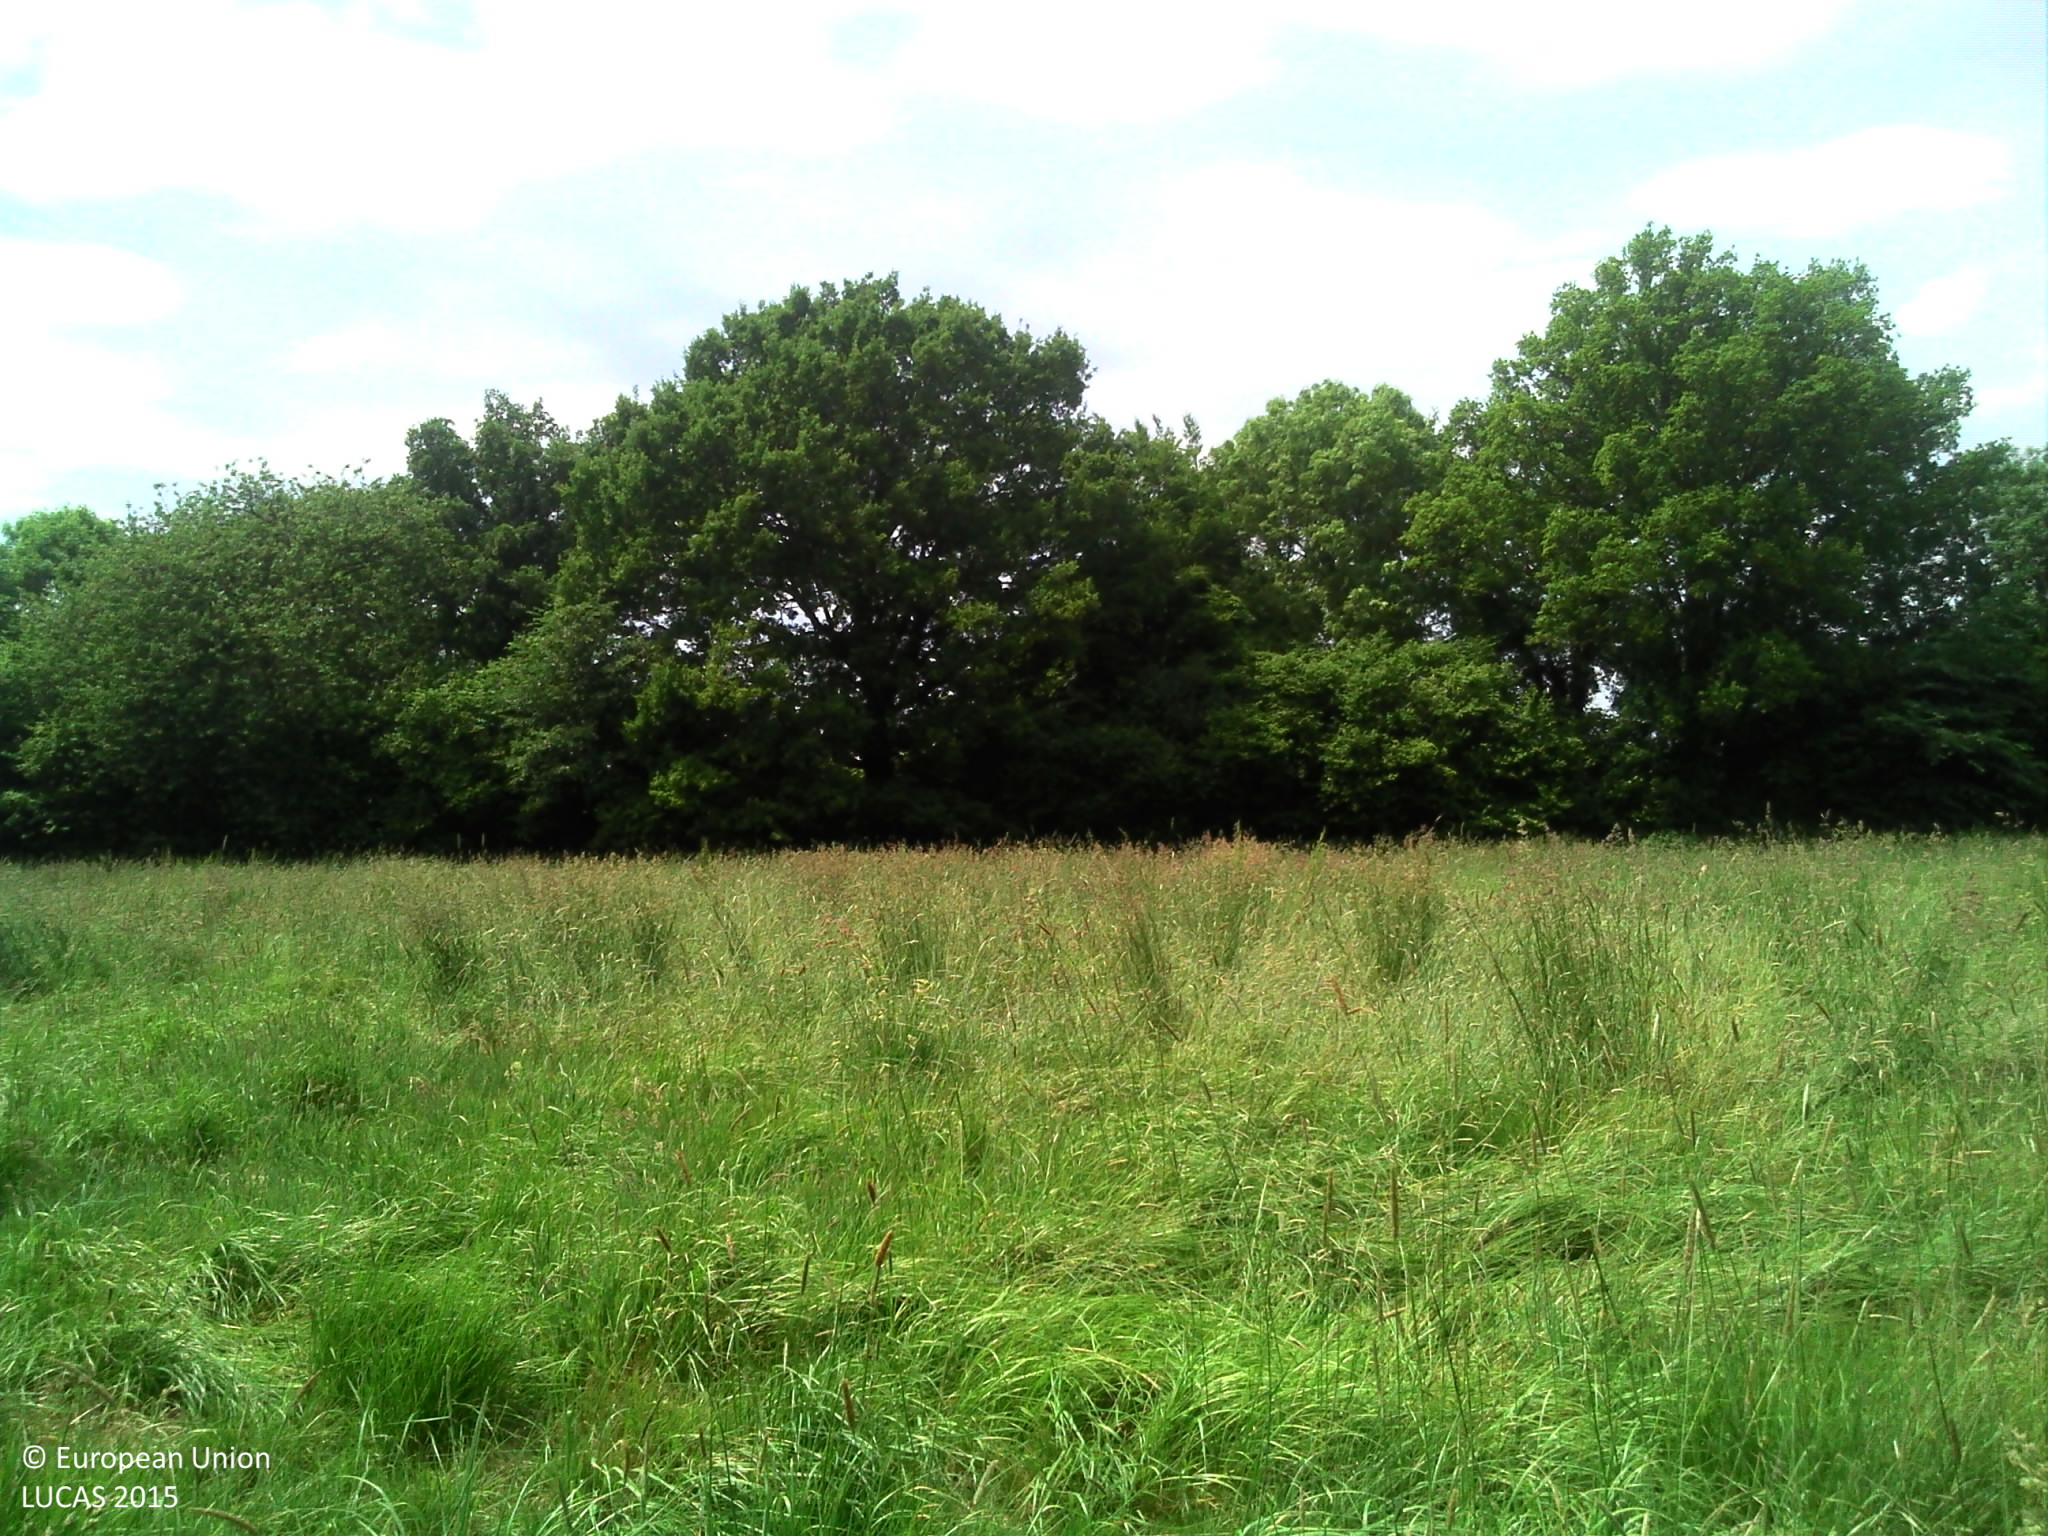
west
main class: Grassland
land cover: Grassland without tree/shrub cover
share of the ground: > 75 %
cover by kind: herbaceous plants 95 %
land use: Agriculture (excluding fallow land and kitchen gardens)
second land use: Forestry
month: June
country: FR
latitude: 48.6900
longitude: 0.1772
